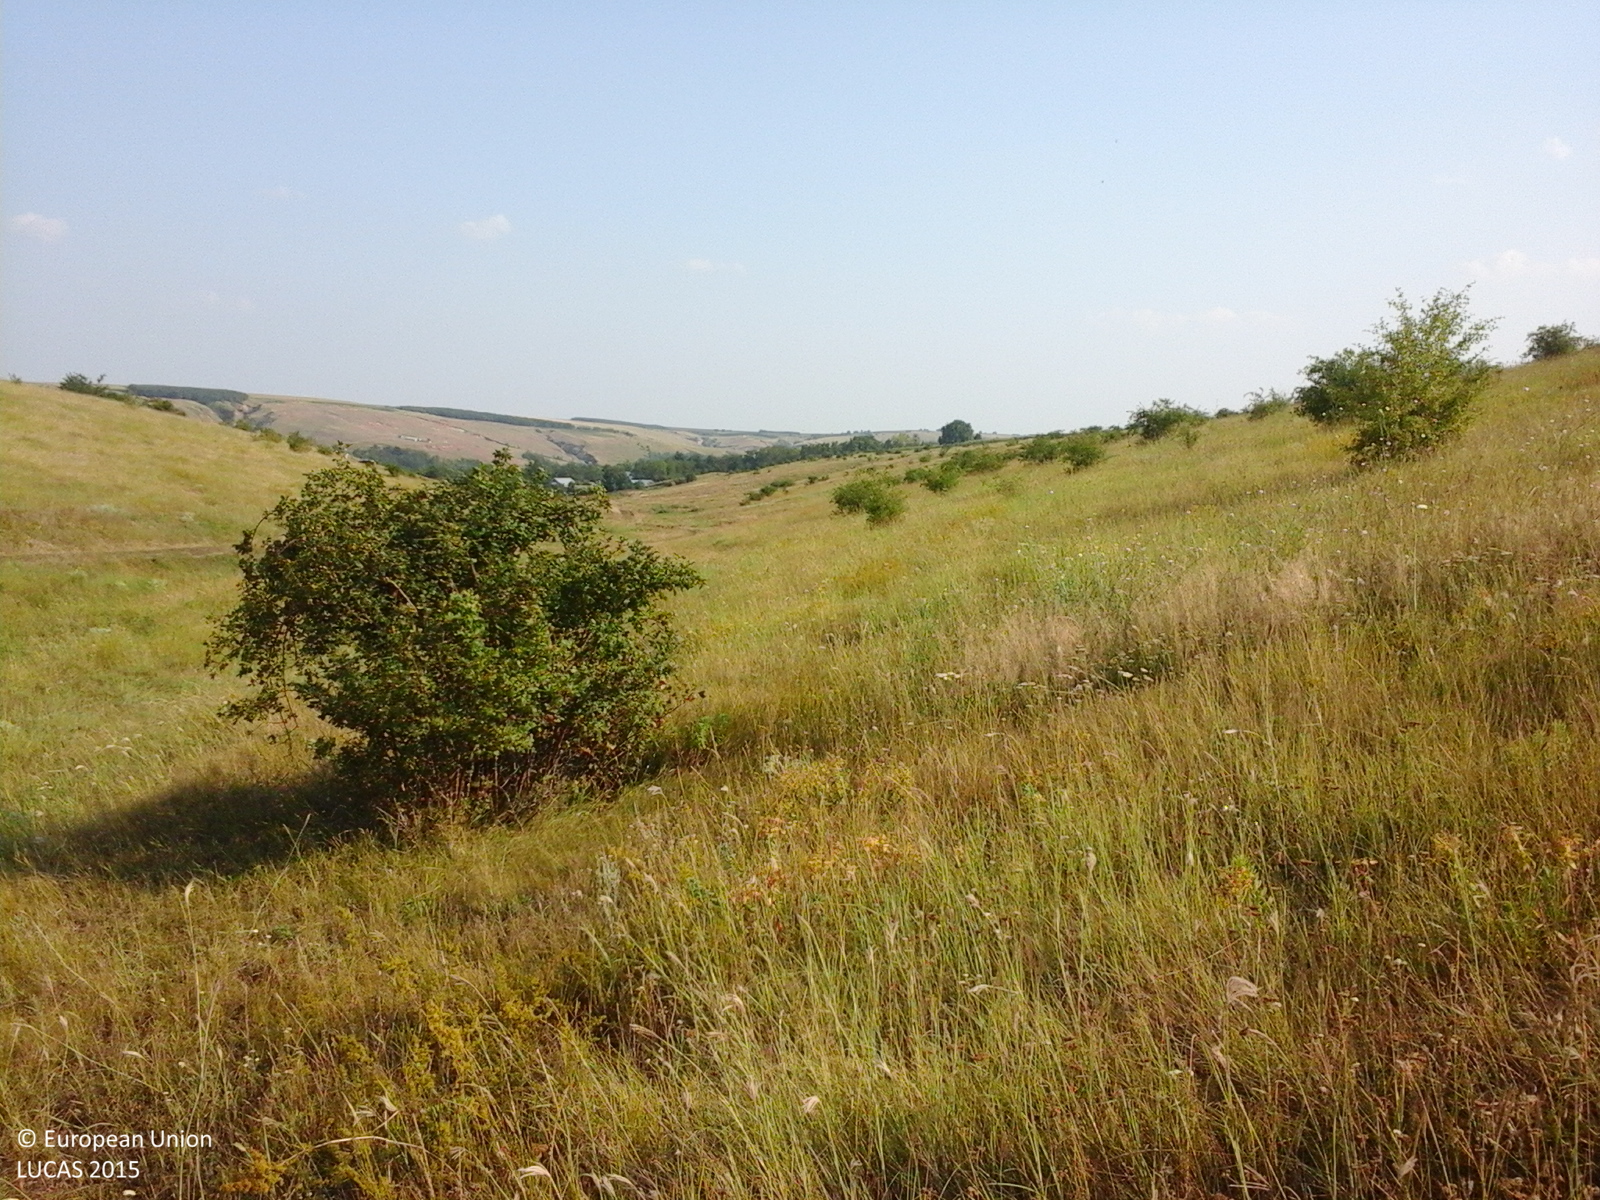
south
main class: Grassland
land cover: Grassland with sparse tree/shrub cover
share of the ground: > 75 %
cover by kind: herbaceous plants 90 %, broadleaved forest trees 5 %, shrubs 5 %
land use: Agriculture (excluding fallow land and kitchen gardens)
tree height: < 5 m
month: July
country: RO
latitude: 45.9386
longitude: 27.6390
